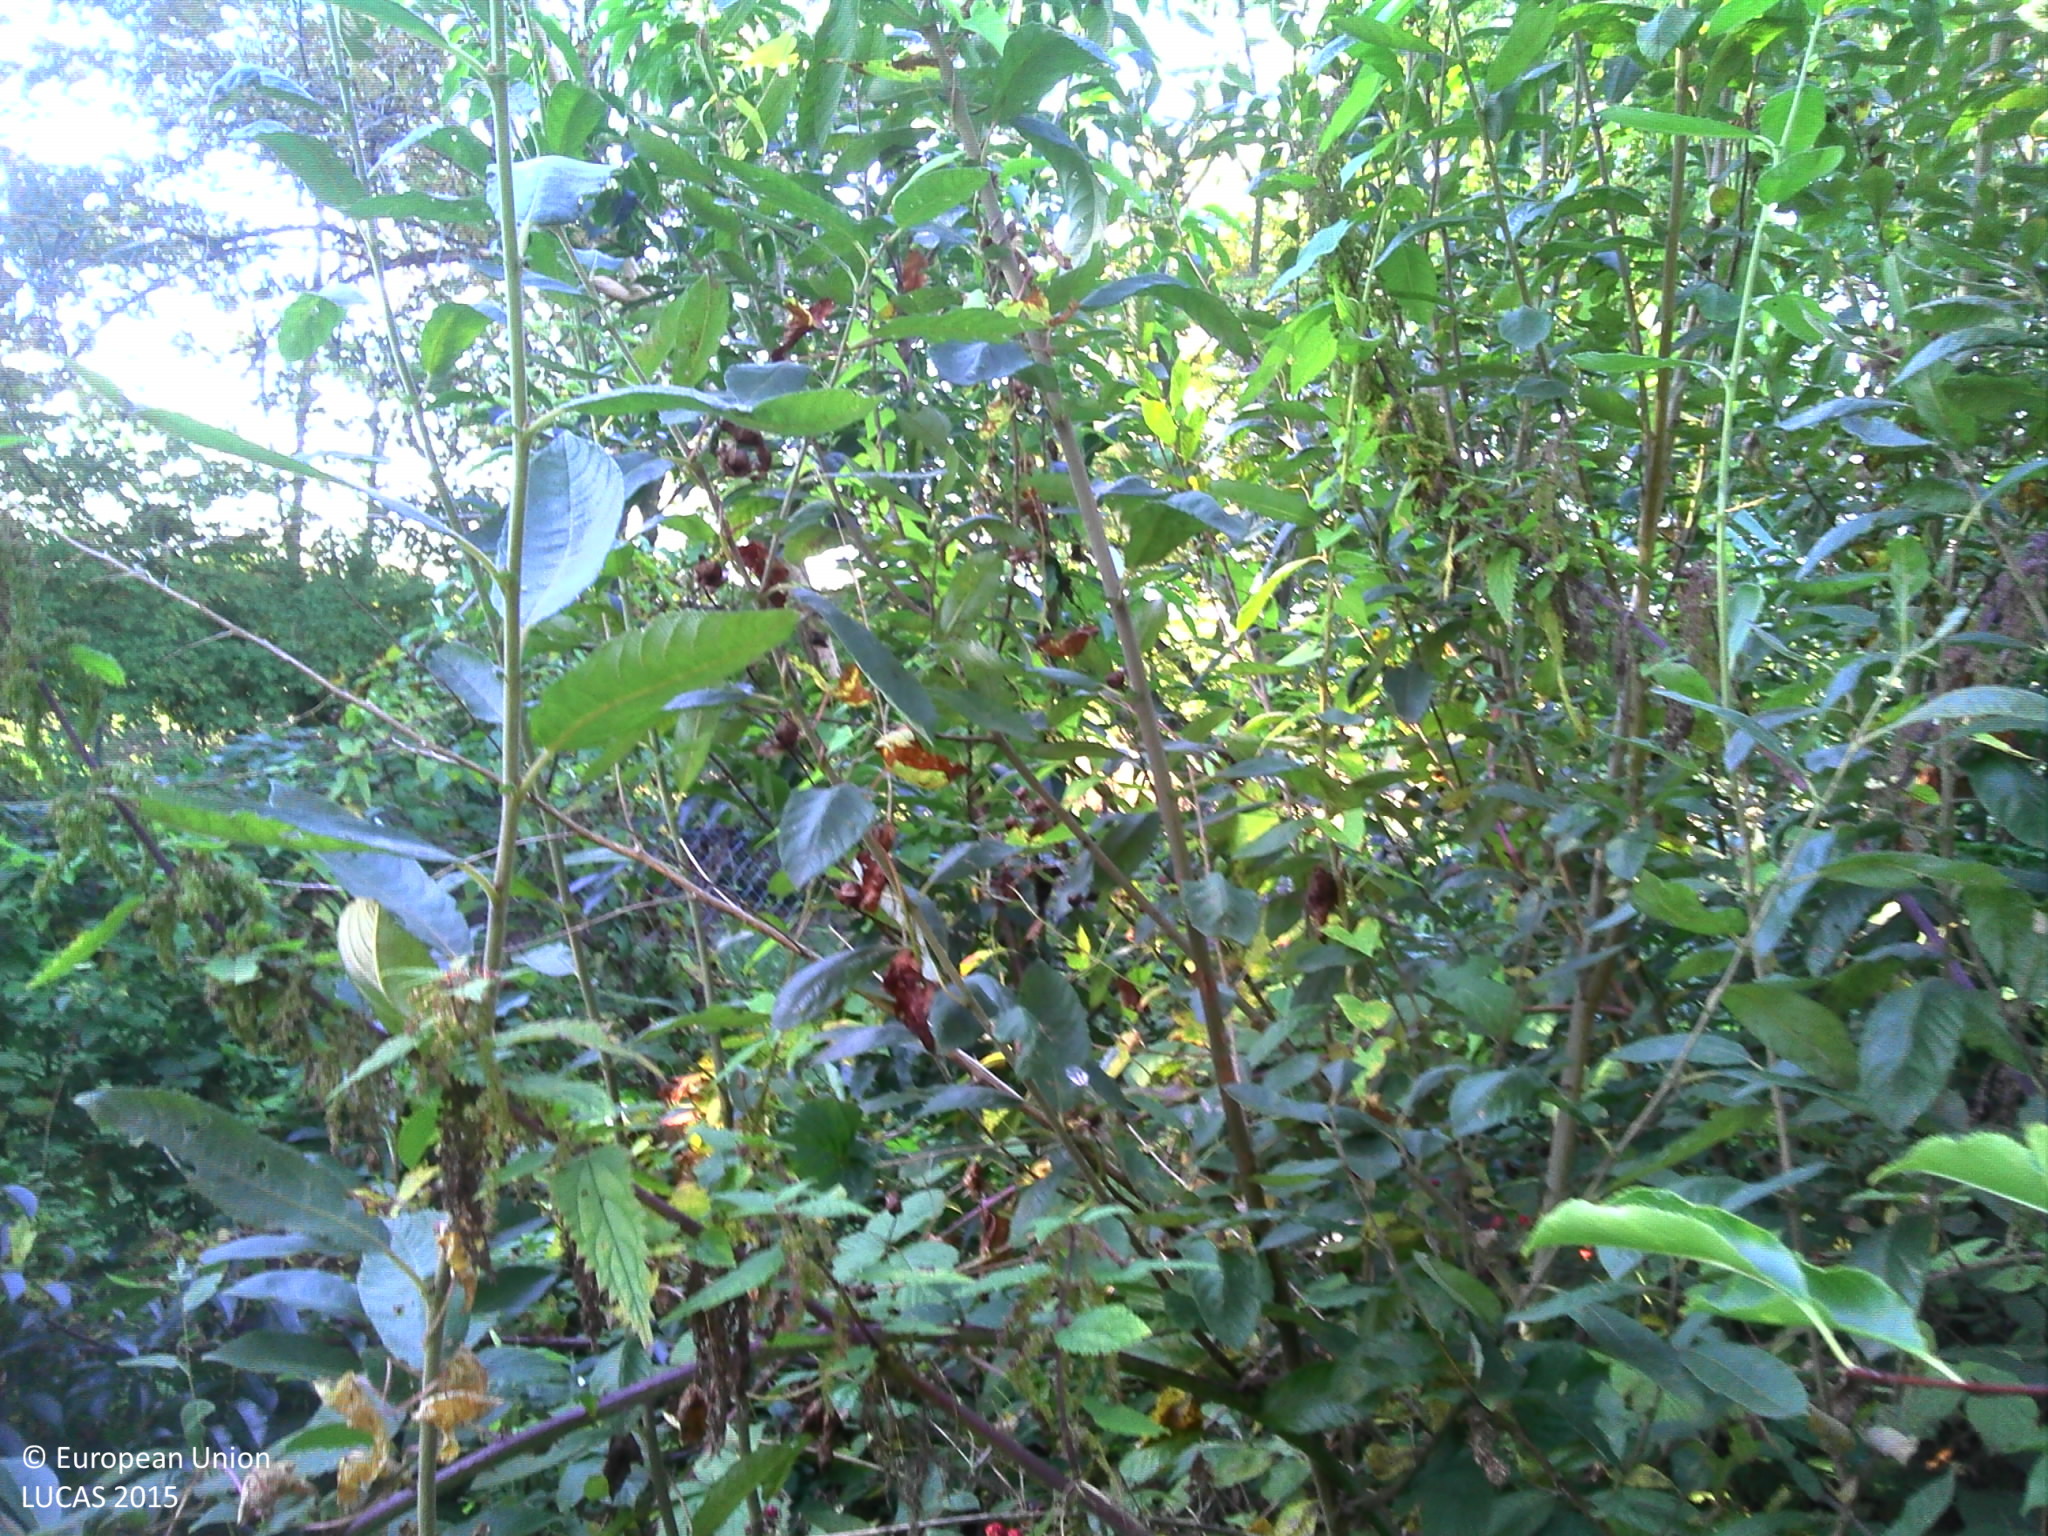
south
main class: Cropland
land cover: Apple fruit
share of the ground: > 75 %
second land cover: Grassland without tree/shrub cover
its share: > 75 %
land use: Agriculture (excluding fallow land and kitchen gardens)
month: September
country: BE
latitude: 51.1943
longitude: 4.6587
